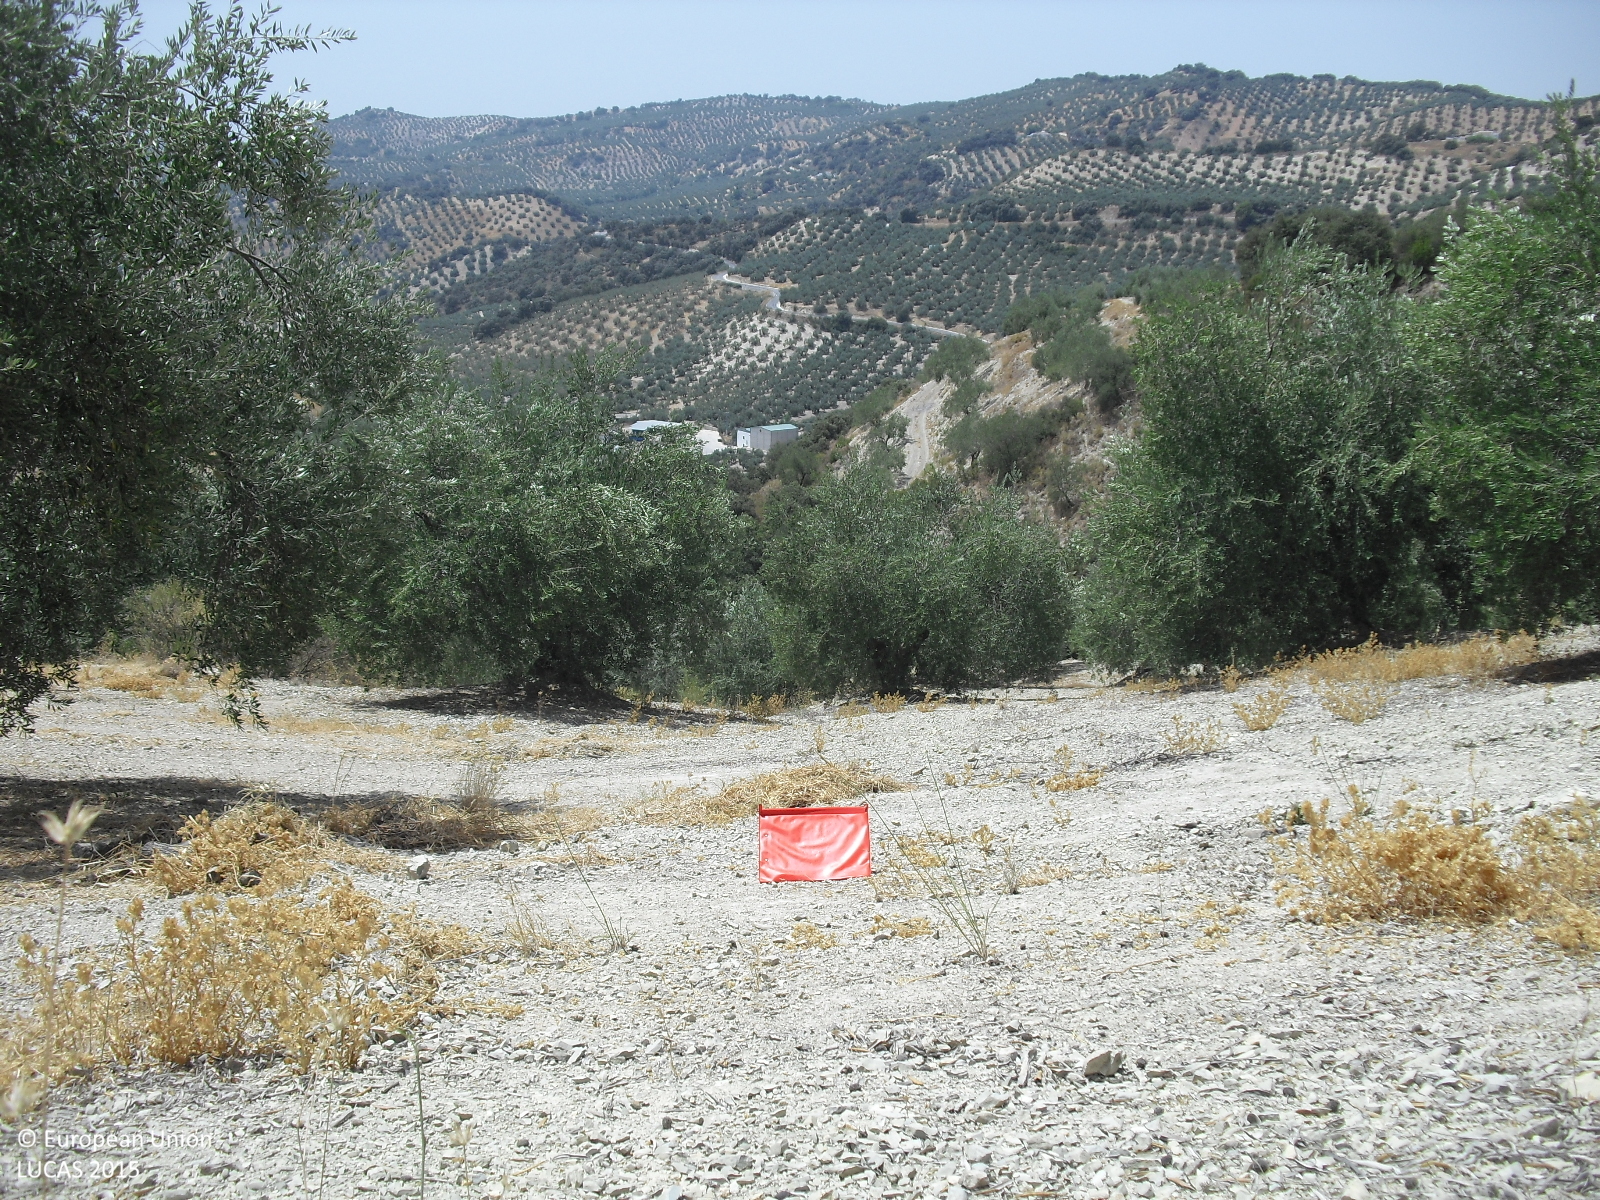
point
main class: Cropland
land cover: Olive groves
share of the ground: 25 - 50 %
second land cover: Other bare soil
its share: > 75 %
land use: Agriculture (excluding fallow land and kitchen gardens)
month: August
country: ES
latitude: 37.3576
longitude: -4.1900
